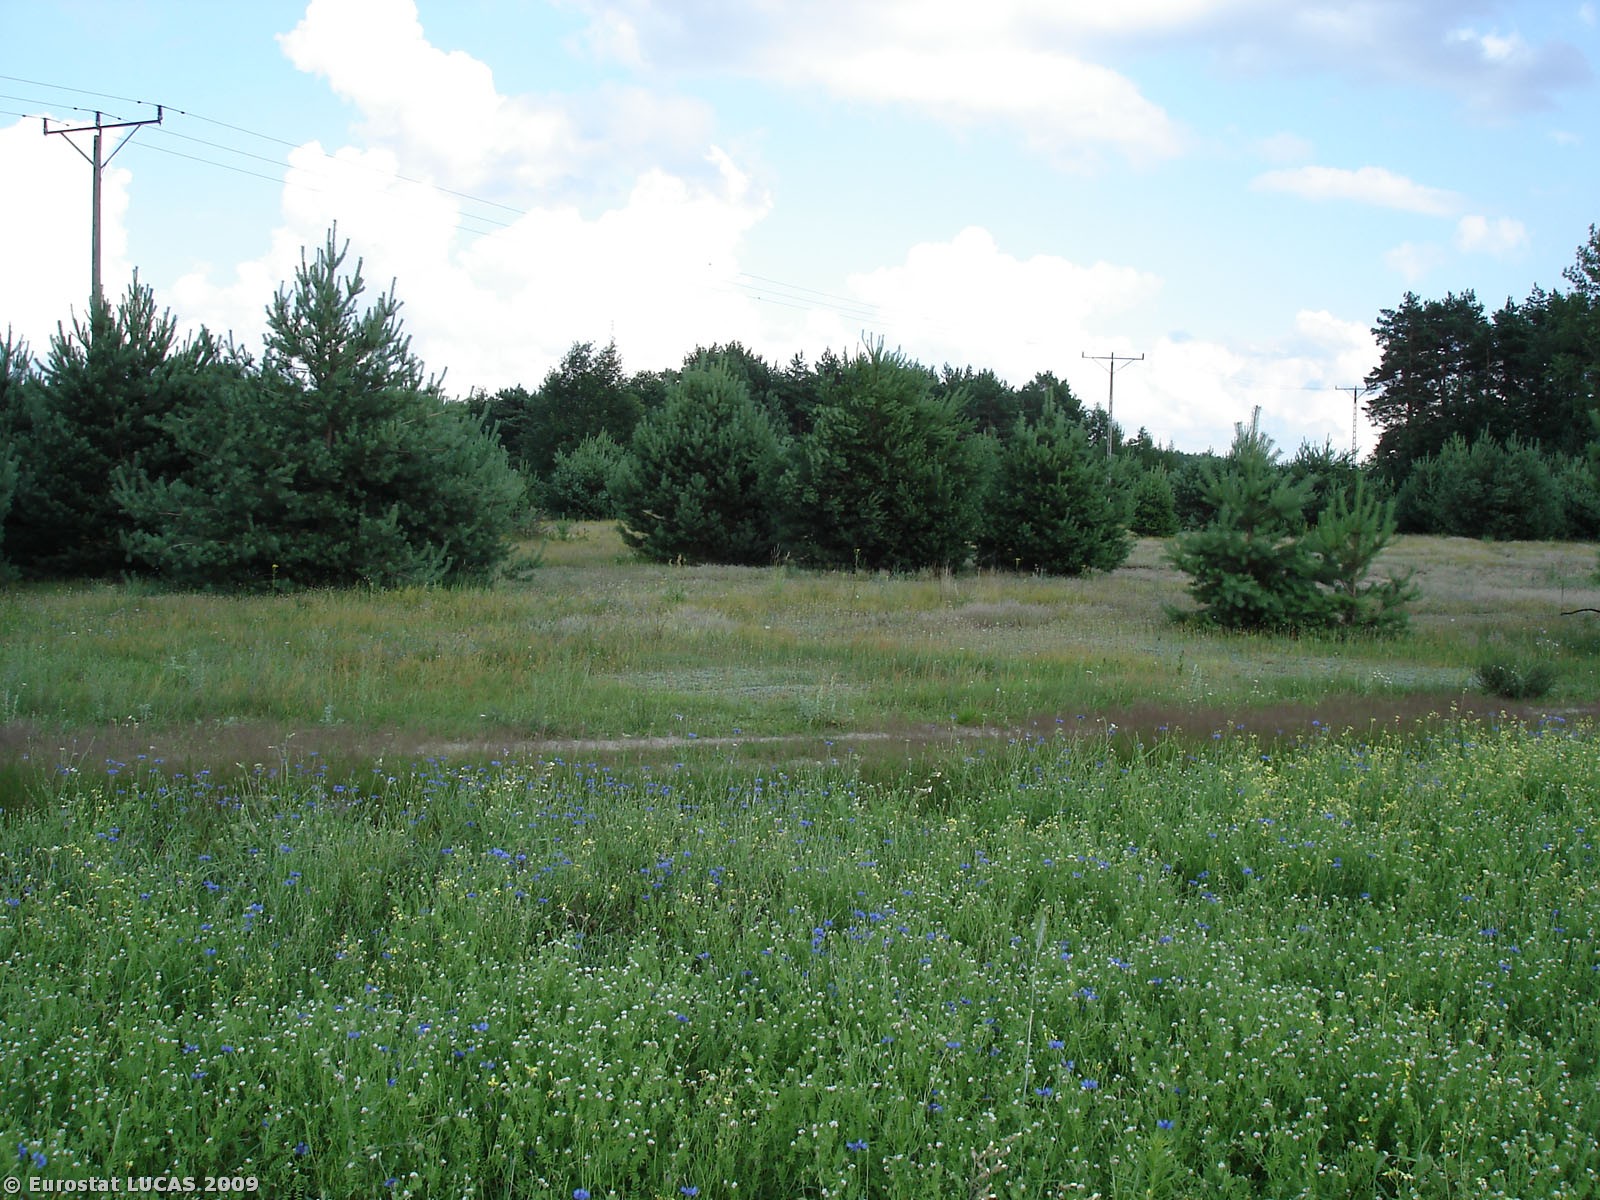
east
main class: Cropland
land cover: Lucerne
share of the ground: > 75 %
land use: Agriculture (excluding fallow land and kitchen gardens)
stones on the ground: < 10 %
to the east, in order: Lucerne; Grass margins; Tracks; Grassland without tree/shrub cover; Electric lines; Grassland without tree/shrub cover; Coniferous woodland; Grassland without tree/shrub cover; Mixed woodland
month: March
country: PL
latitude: 51.0019
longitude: 19.9073
